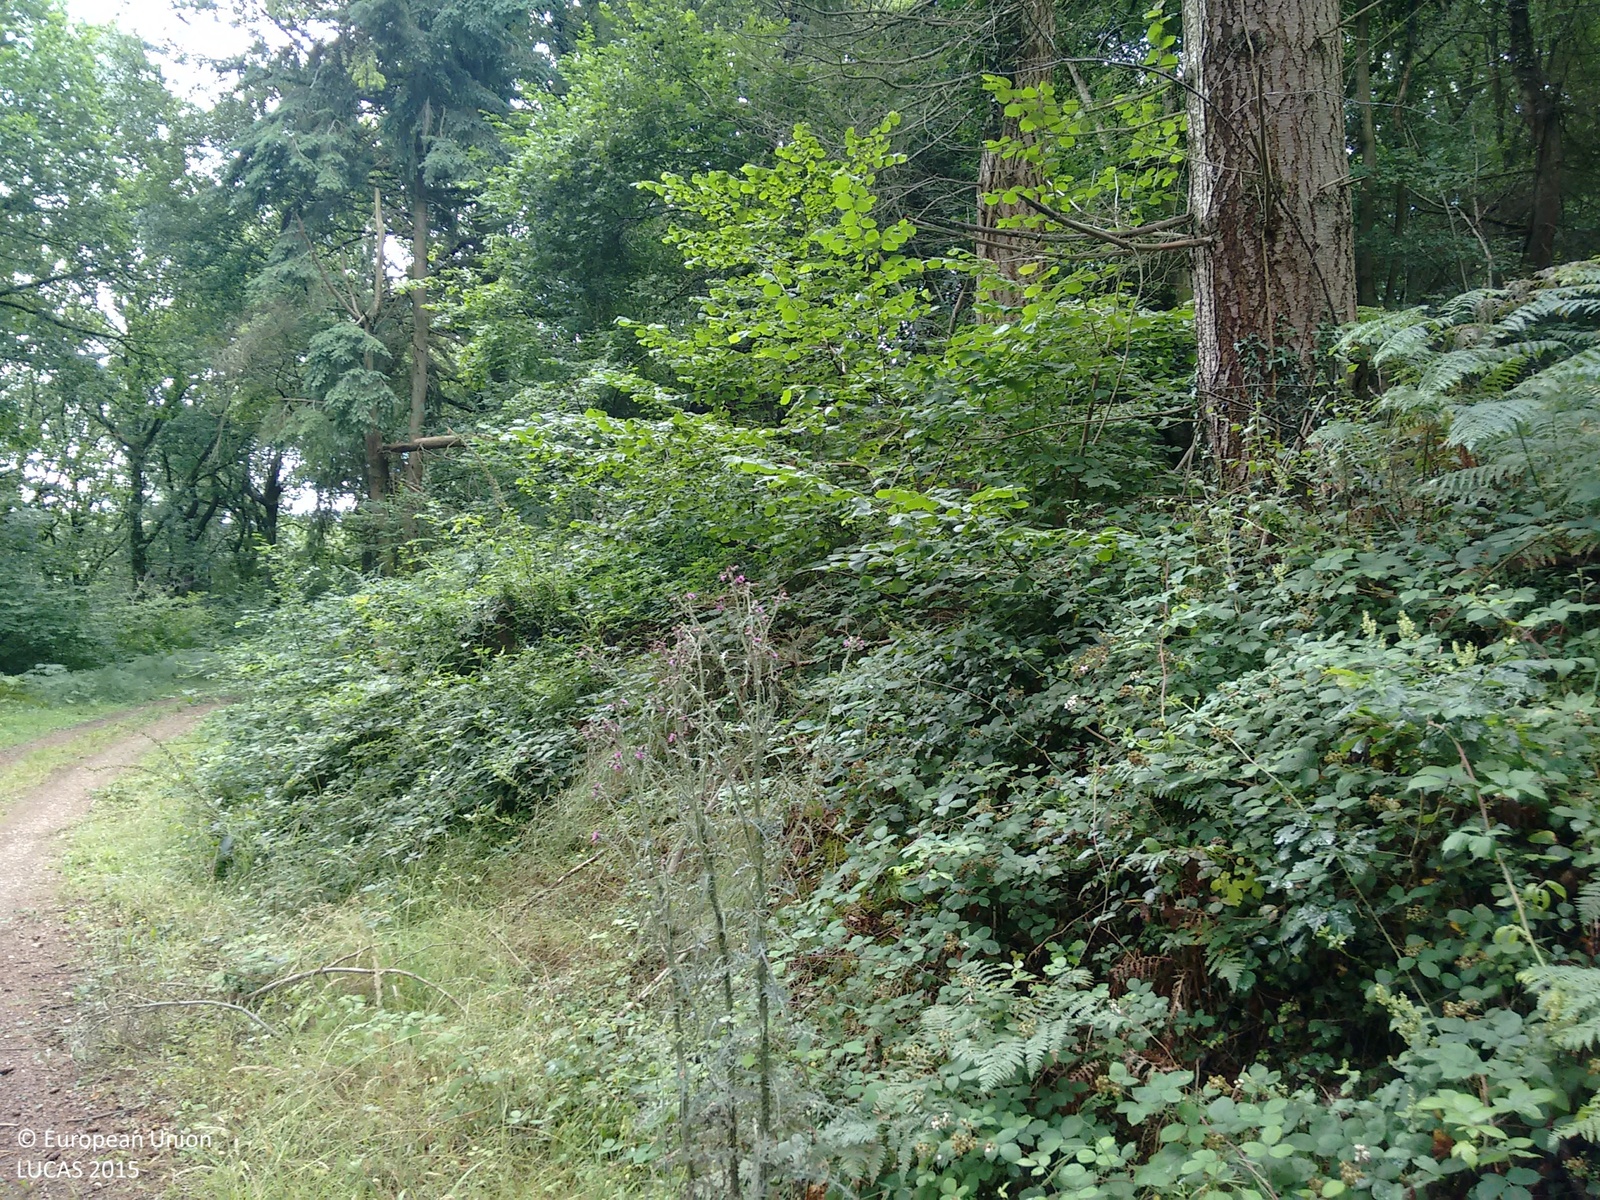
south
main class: Woodland
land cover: Spruce dominated coniferous woodland
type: exotic forest
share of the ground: > 75 %
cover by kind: coniferous forest trees 100 %
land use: Forestry
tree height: > 5 m
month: August
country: GB
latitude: 50.7482
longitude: -3.6215
